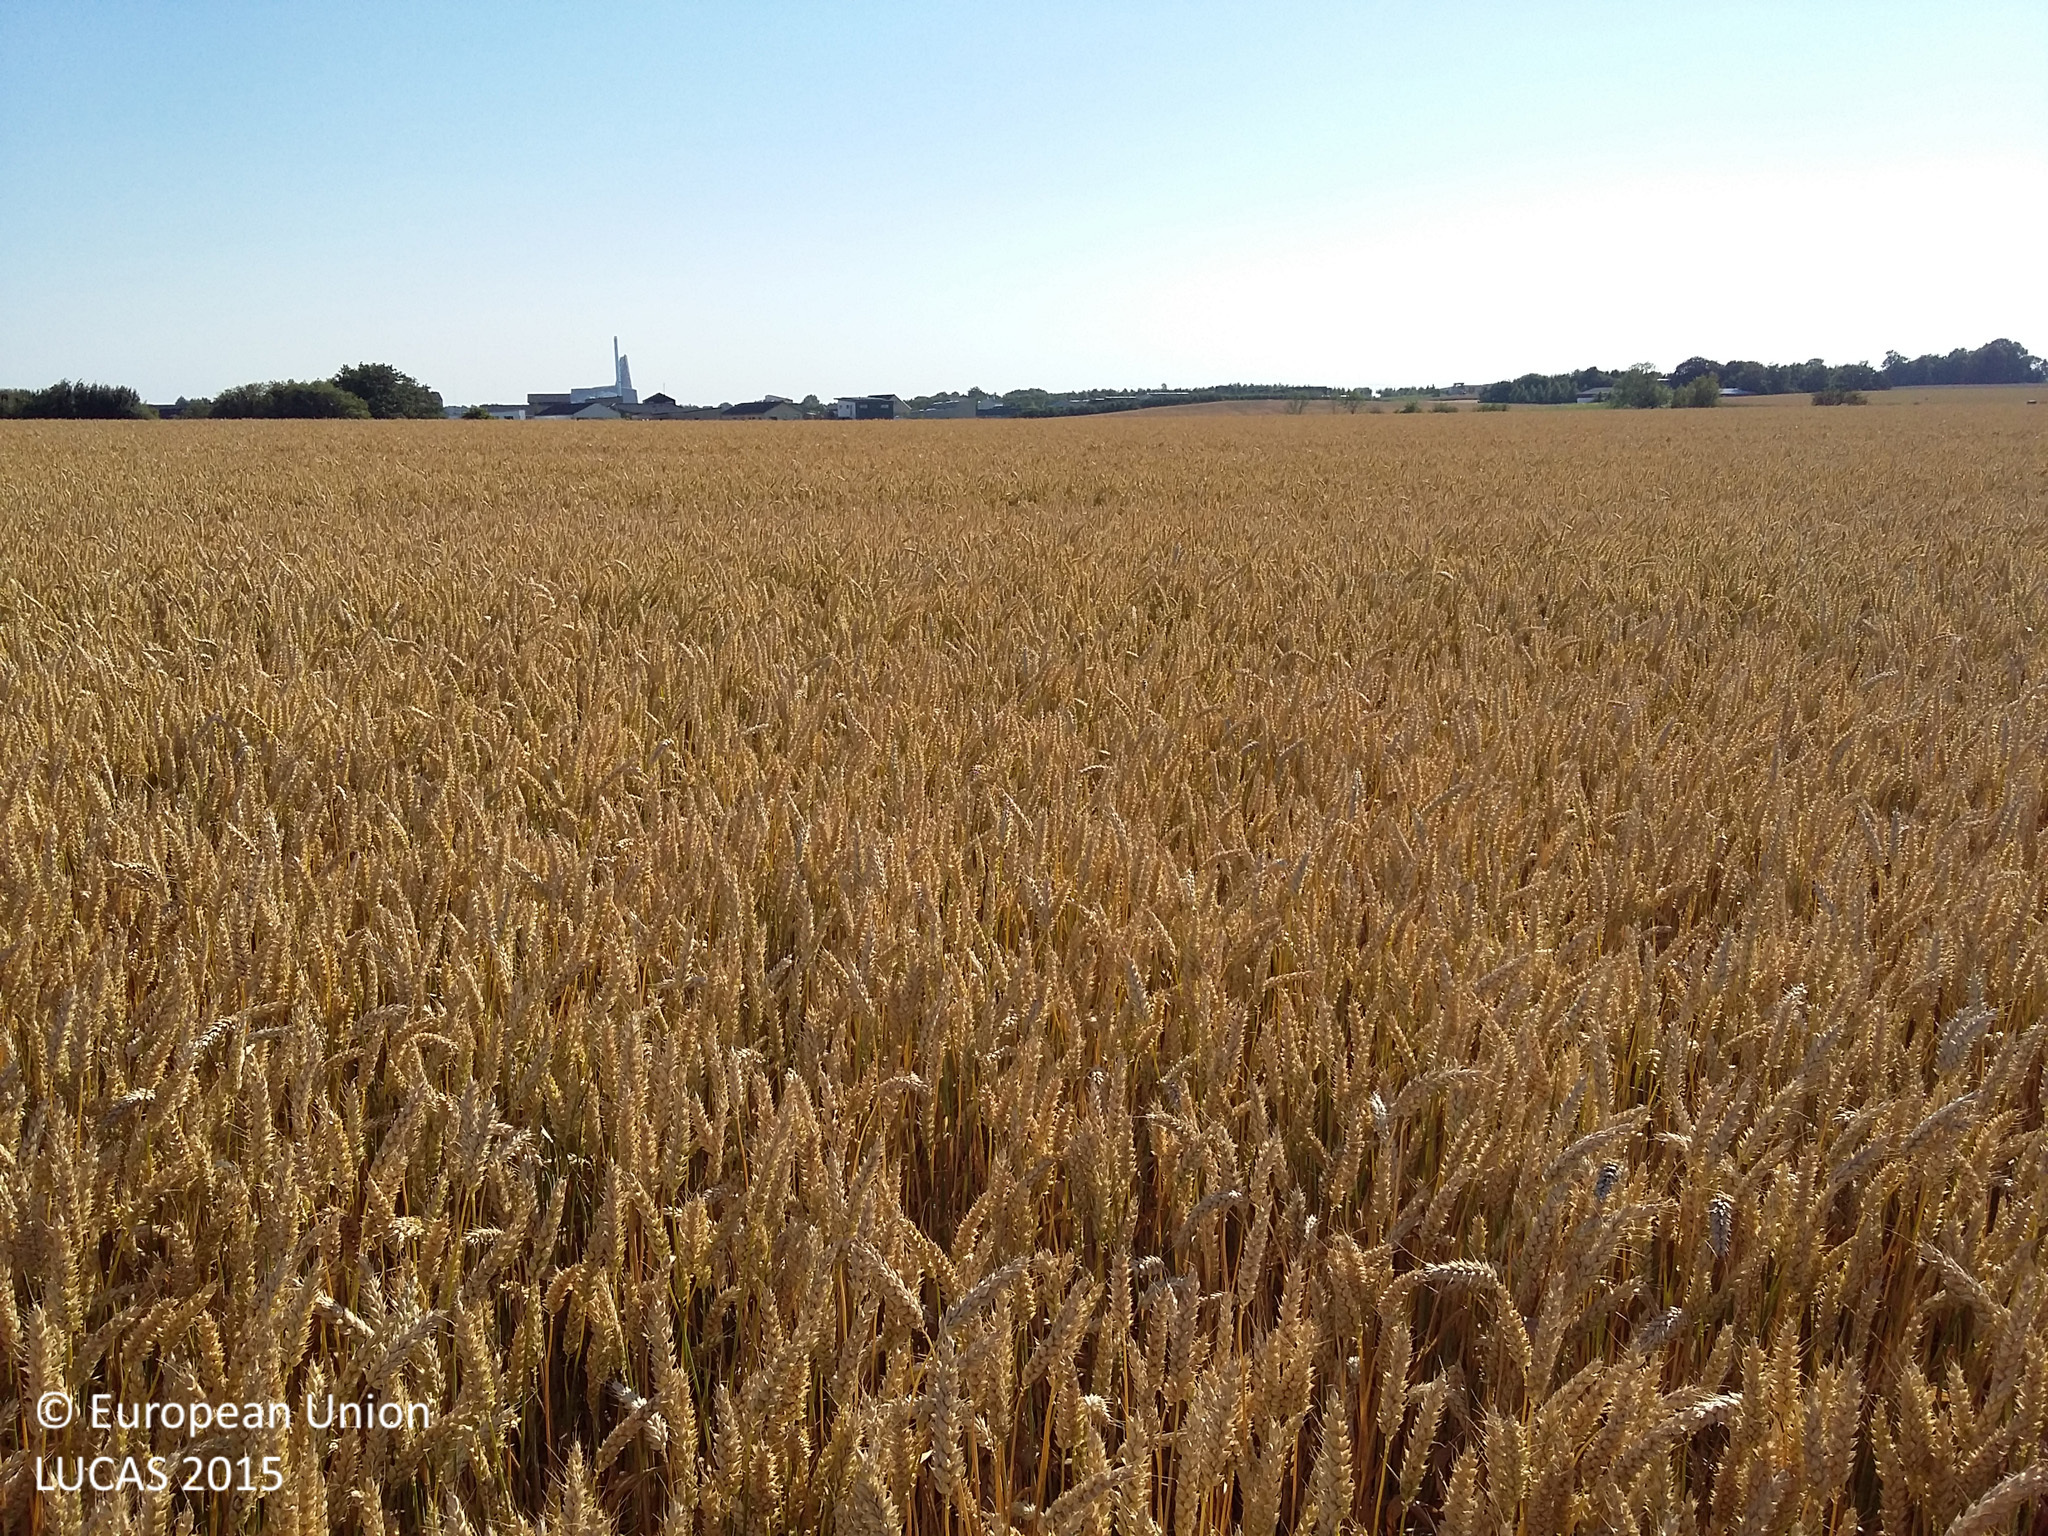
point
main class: Cropland
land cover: Common wheat
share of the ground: > 75 %
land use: Agriculture (excluding fallow land and kitchen gardens)
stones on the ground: < 10 %
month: August
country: DK
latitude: 55.6664
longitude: 12.1444
